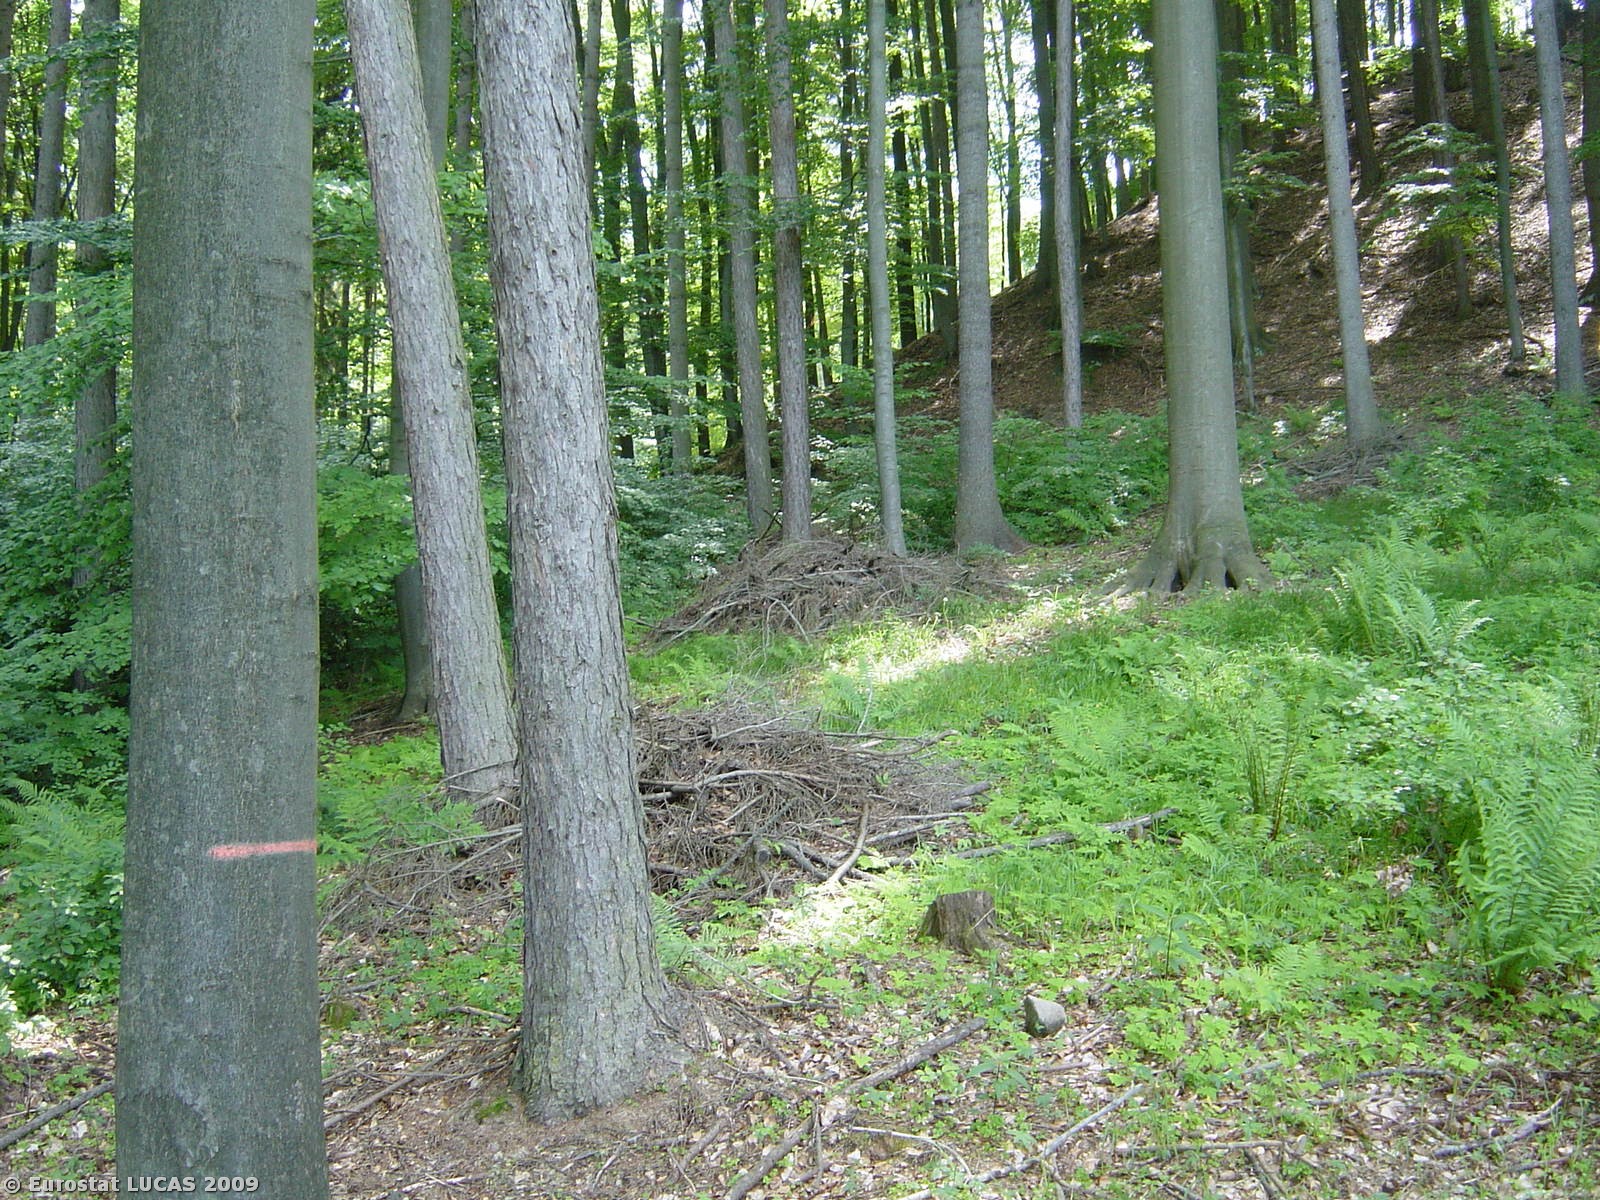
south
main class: Woodland
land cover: Mixed woodland
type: hemiboreal forest and nemoral coniferous forest and mixed broadleaved-coniferous forest
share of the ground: 50 - 75 %
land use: Forestry
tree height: > 5 m
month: May
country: CZ
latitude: 49.1060
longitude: 17.2290
